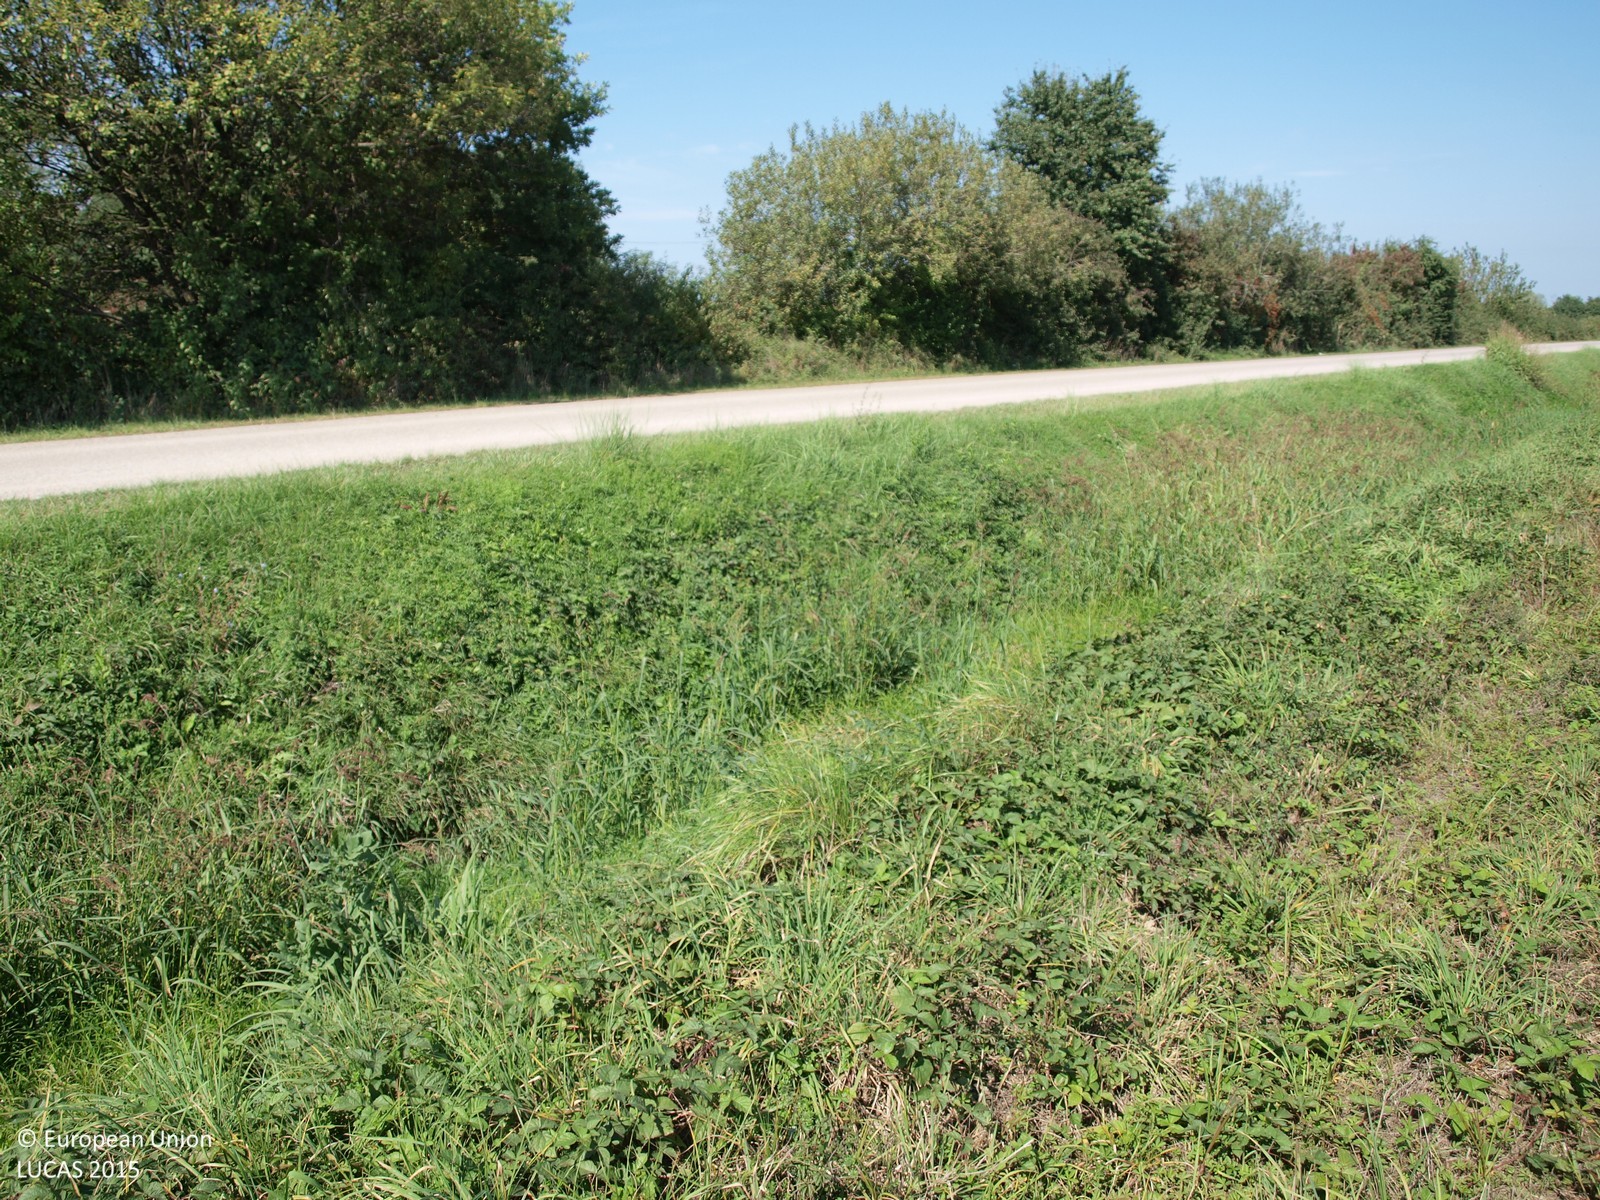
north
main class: Grassland
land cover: Grassland without tree/shrub cover
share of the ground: > 75 %
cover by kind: herbaceous plants 100 %
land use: Agriculture (excluding fallow land and kitchen gardens)
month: September
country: HR
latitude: 45.6536
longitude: 16.0932
